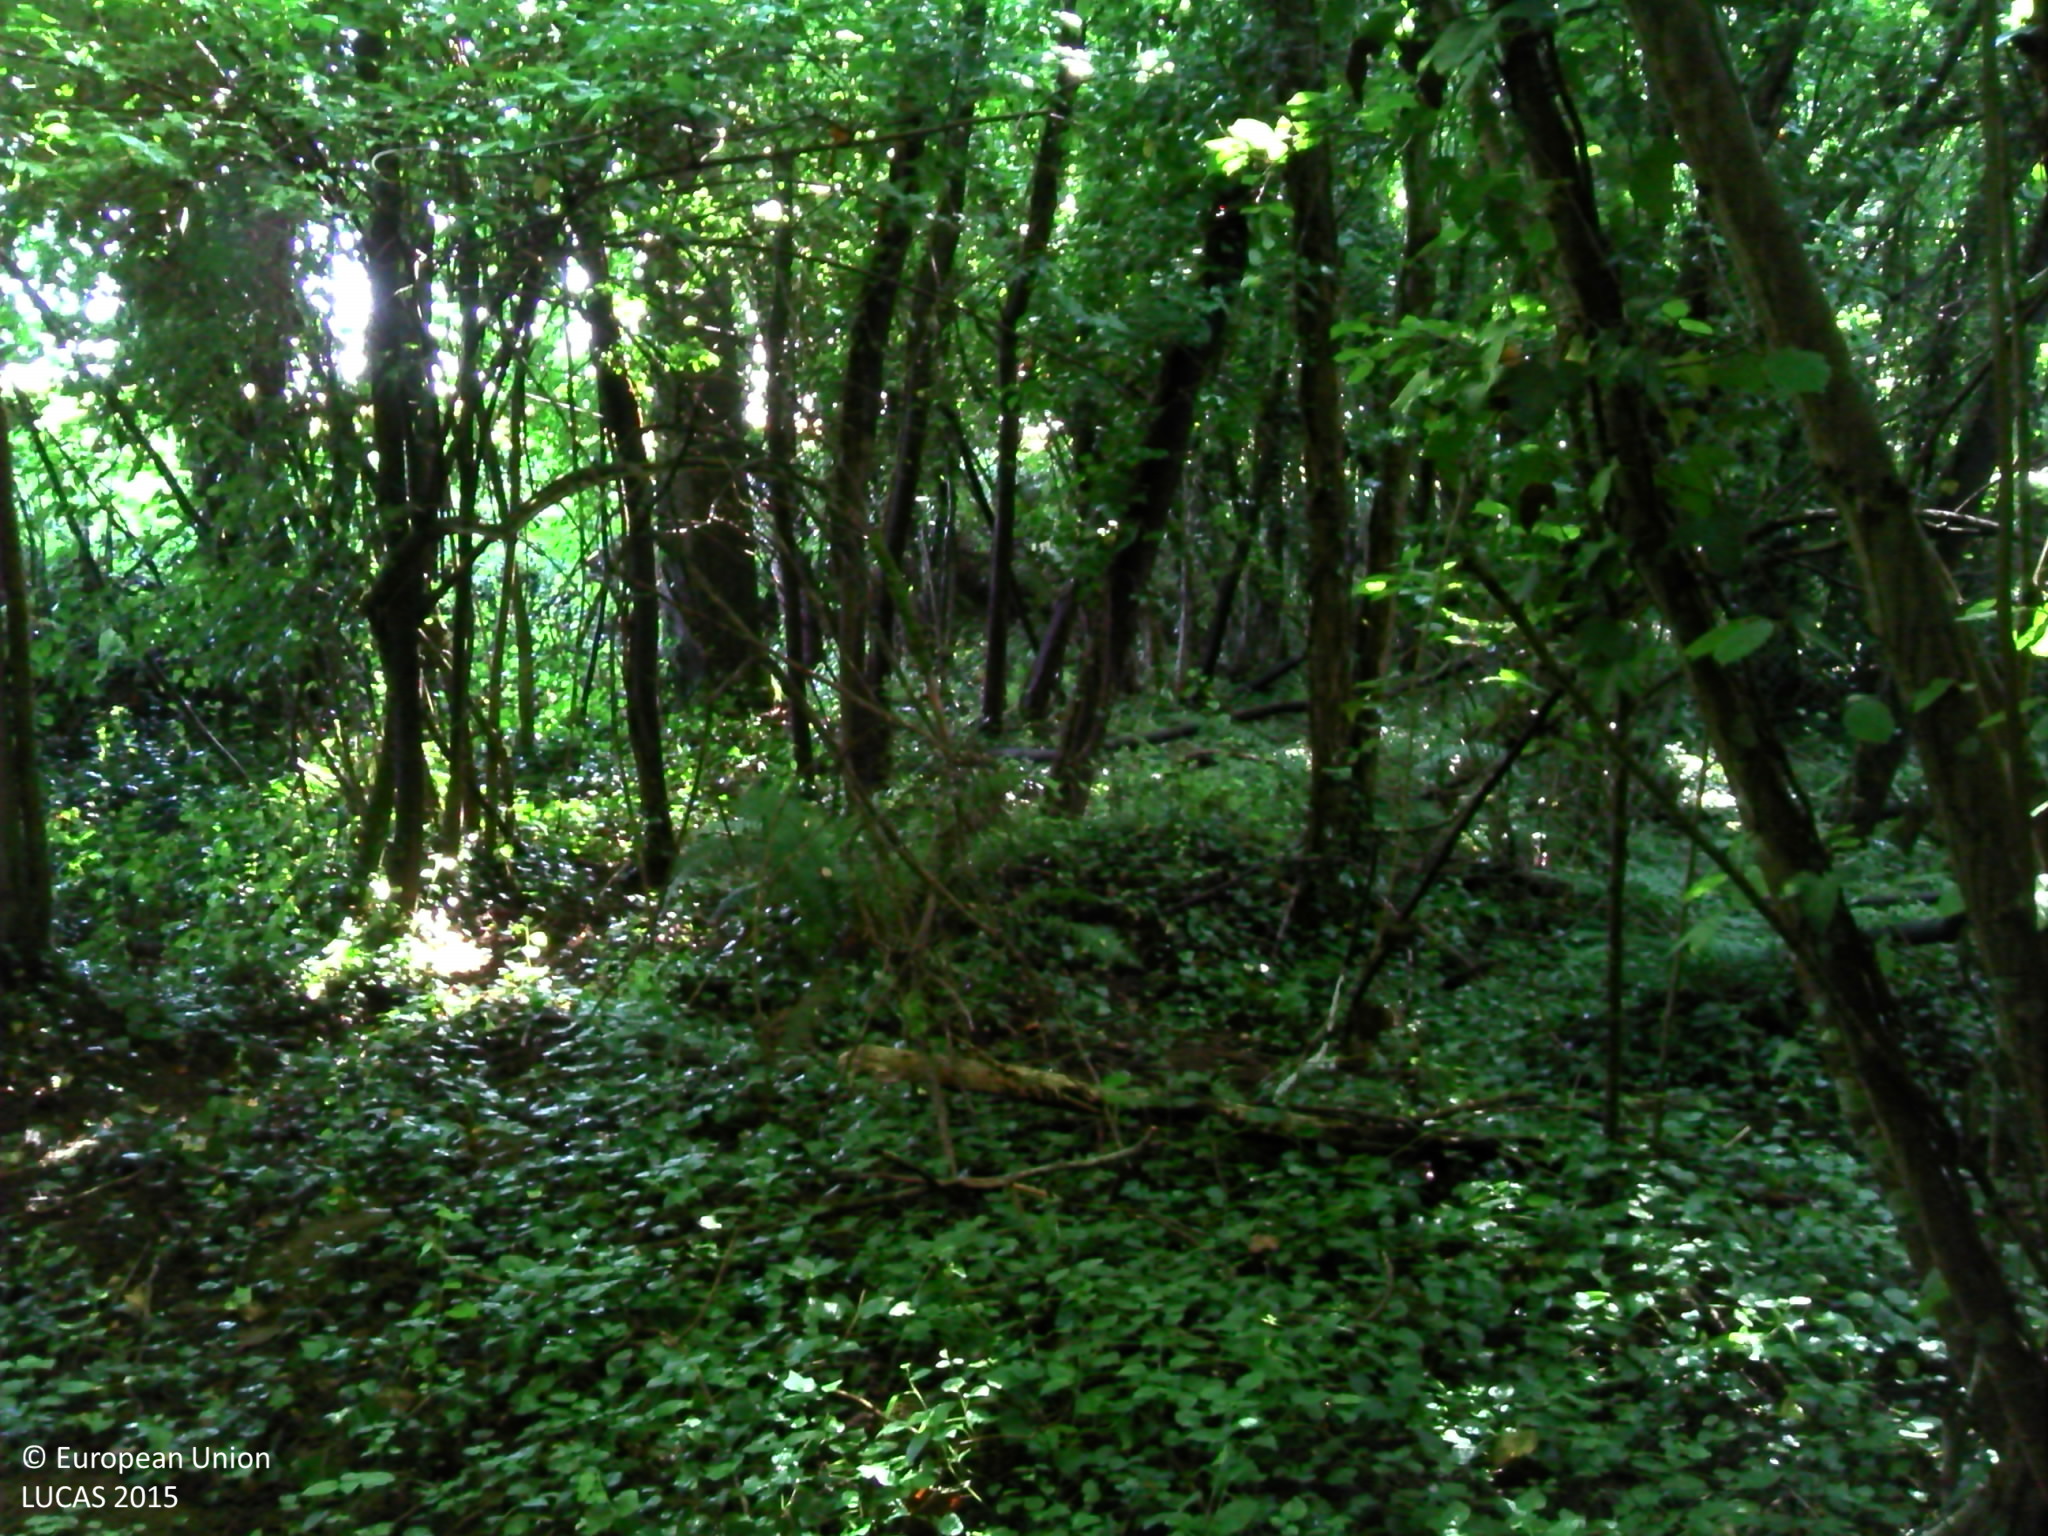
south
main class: Woodland
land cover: Broadleaved woodland
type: mesophytic deciduous forest
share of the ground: > 75 %
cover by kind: herbaceous plants 60 %, broadleaved forest trees 25 %, lichens and mosses 10 %
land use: Forestry
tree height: > 5 m
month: July
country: FR
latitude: 48.2743
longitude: -2.1688
